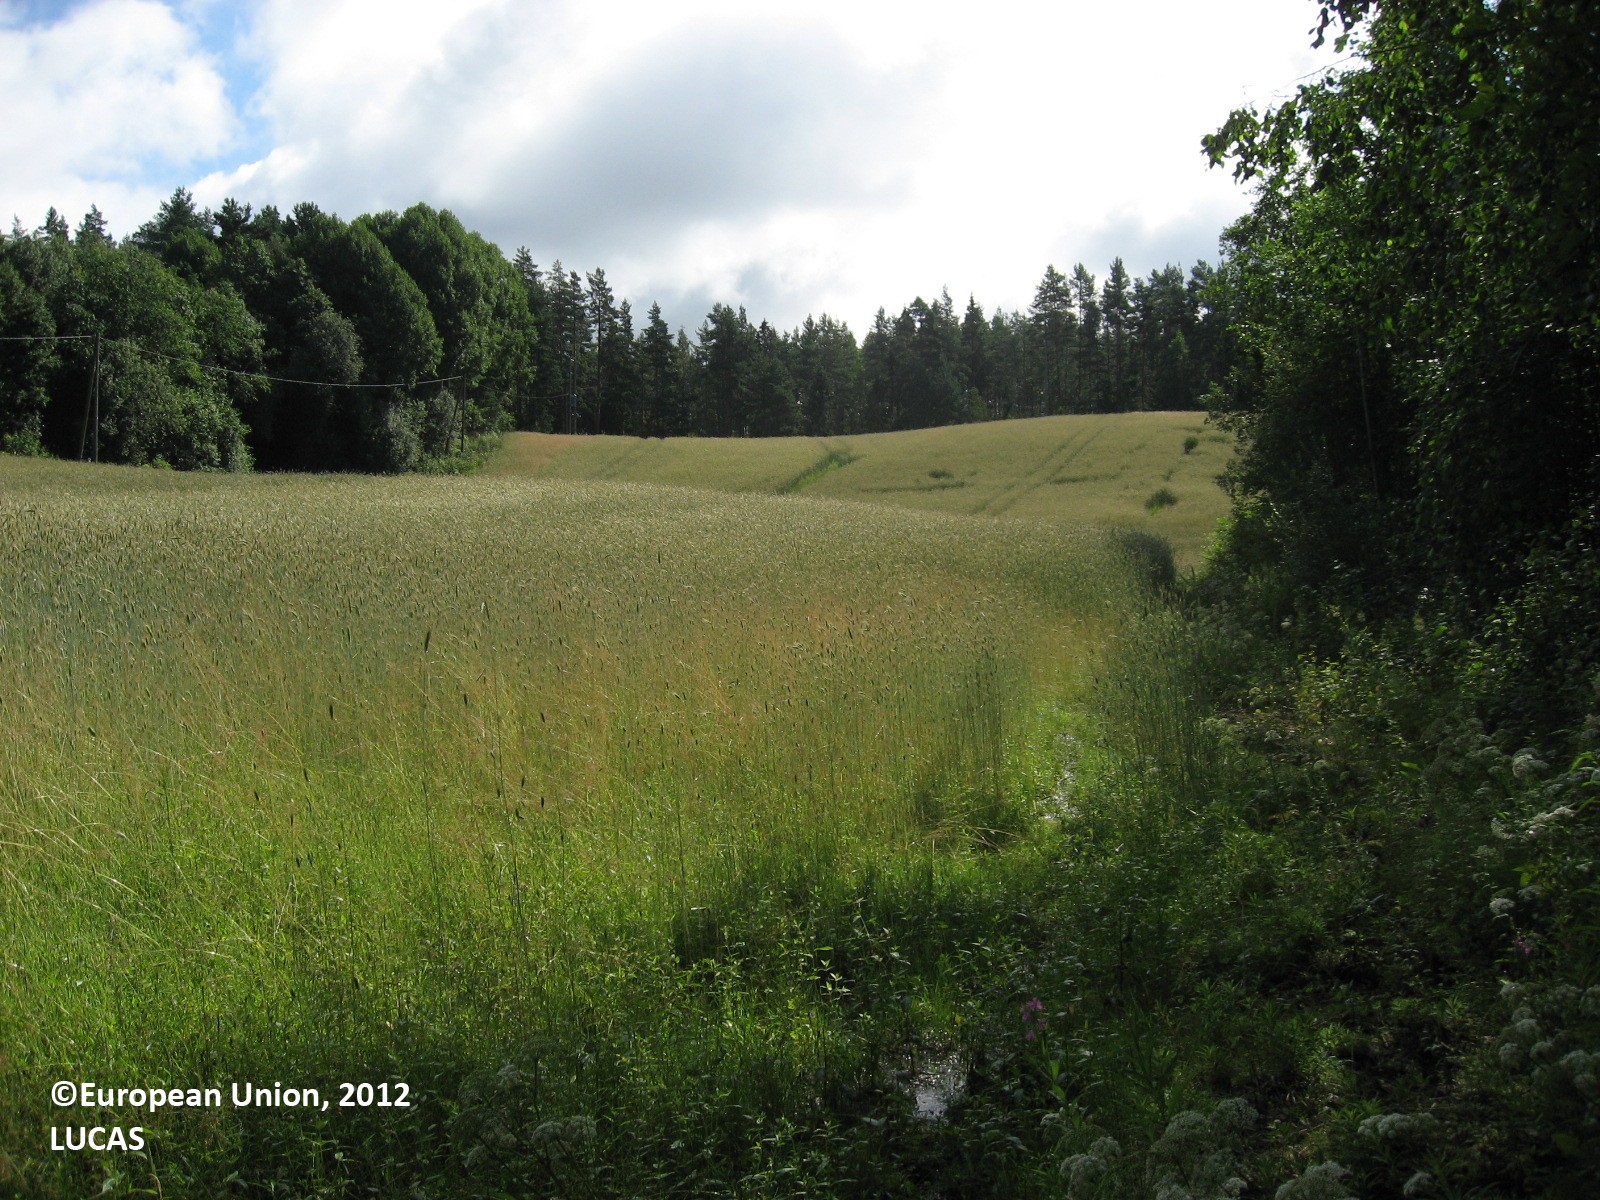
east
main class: Shrubland
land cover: Shrubland with sparse tree cover
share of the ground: > 75 %
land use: Semi-natural and natural areas not in use
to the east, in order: Shrubland with sparse tree cover; Grass margins; Rye; Electric lines; Rye; Electric lines; Grass margins; Paved roads, cycling and walking lanes; Grass margins; Pine dominated coniferous woodland
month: July
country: FI
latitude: 61.1382
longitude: 25.6729
